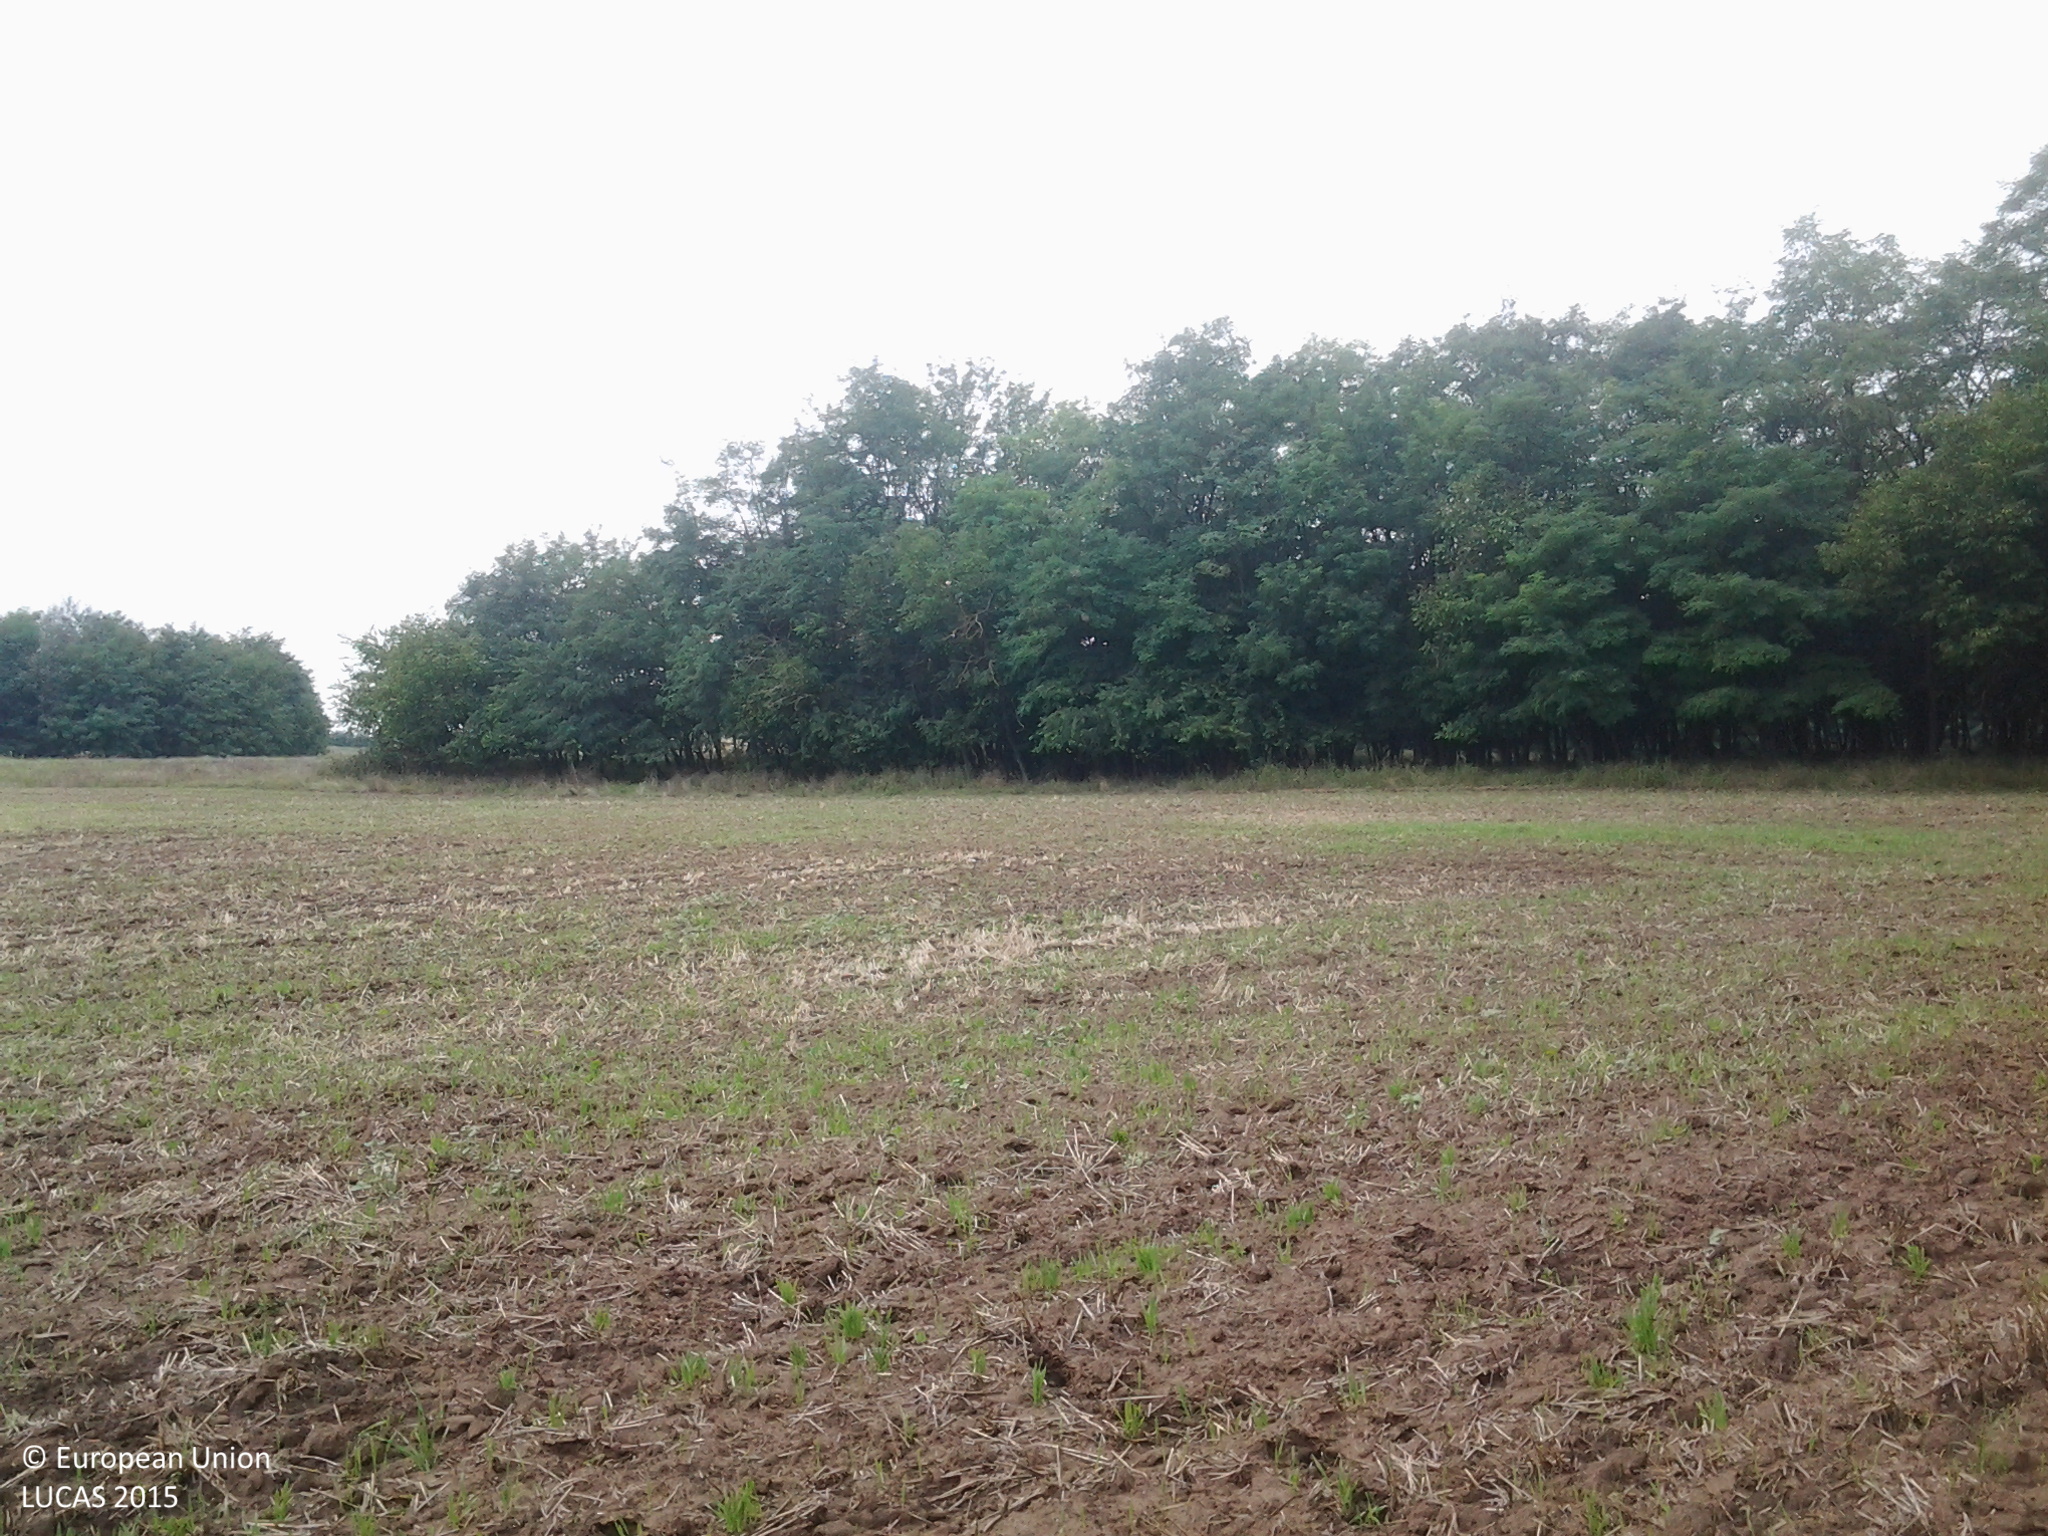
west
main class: Woodland
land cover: Broadleaved woodland
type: mesophytic deciduous forest
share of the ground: > 75 %
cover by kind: broadleaved forest trees 80 %, herbaceous plants 15 %, shrubs 5 %
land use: Forestry
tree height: > 5 m
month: August
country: HU
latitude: 46.0507
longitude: 18.9160
